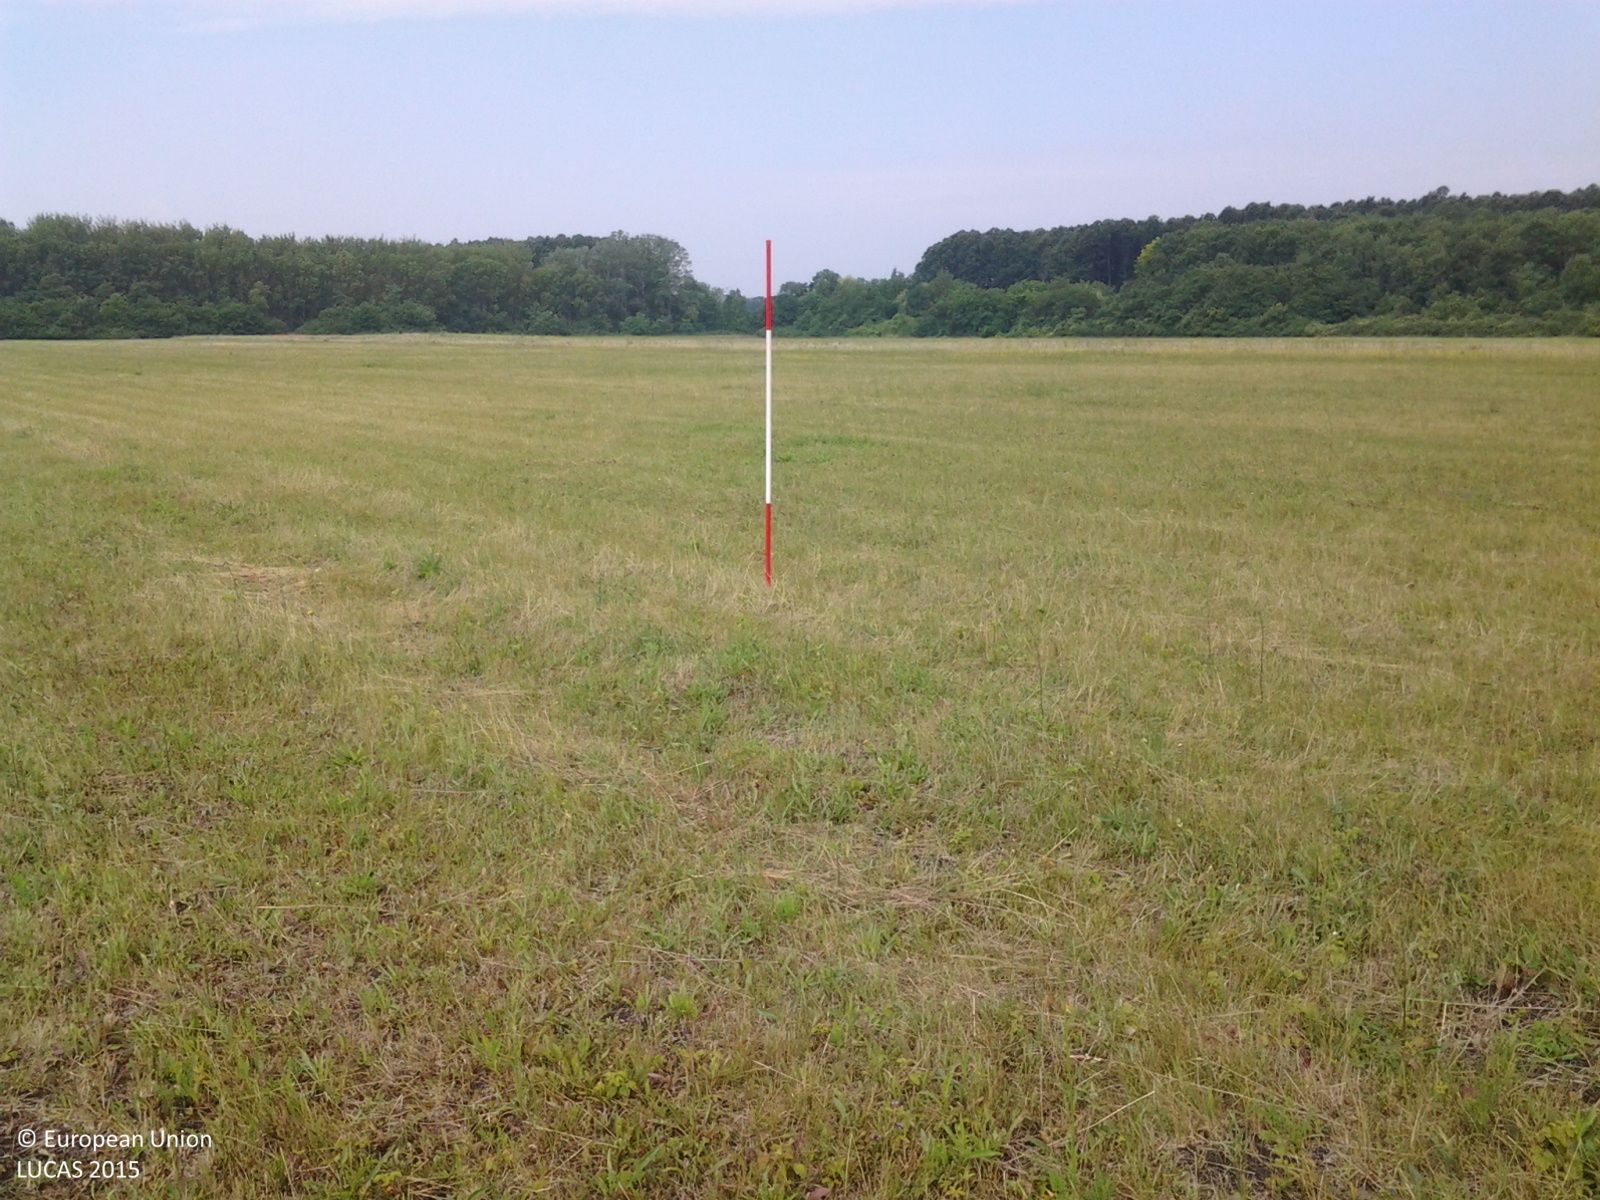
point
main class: Grassland
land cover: Grassland without tree/shrub cover
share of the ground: > 75 %
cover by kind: herbaceous plants 100 %
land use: Agriculture (excluding fallow land and kitchen gardens)
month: June
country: HU
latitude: 46.6864
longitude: 21.2144
